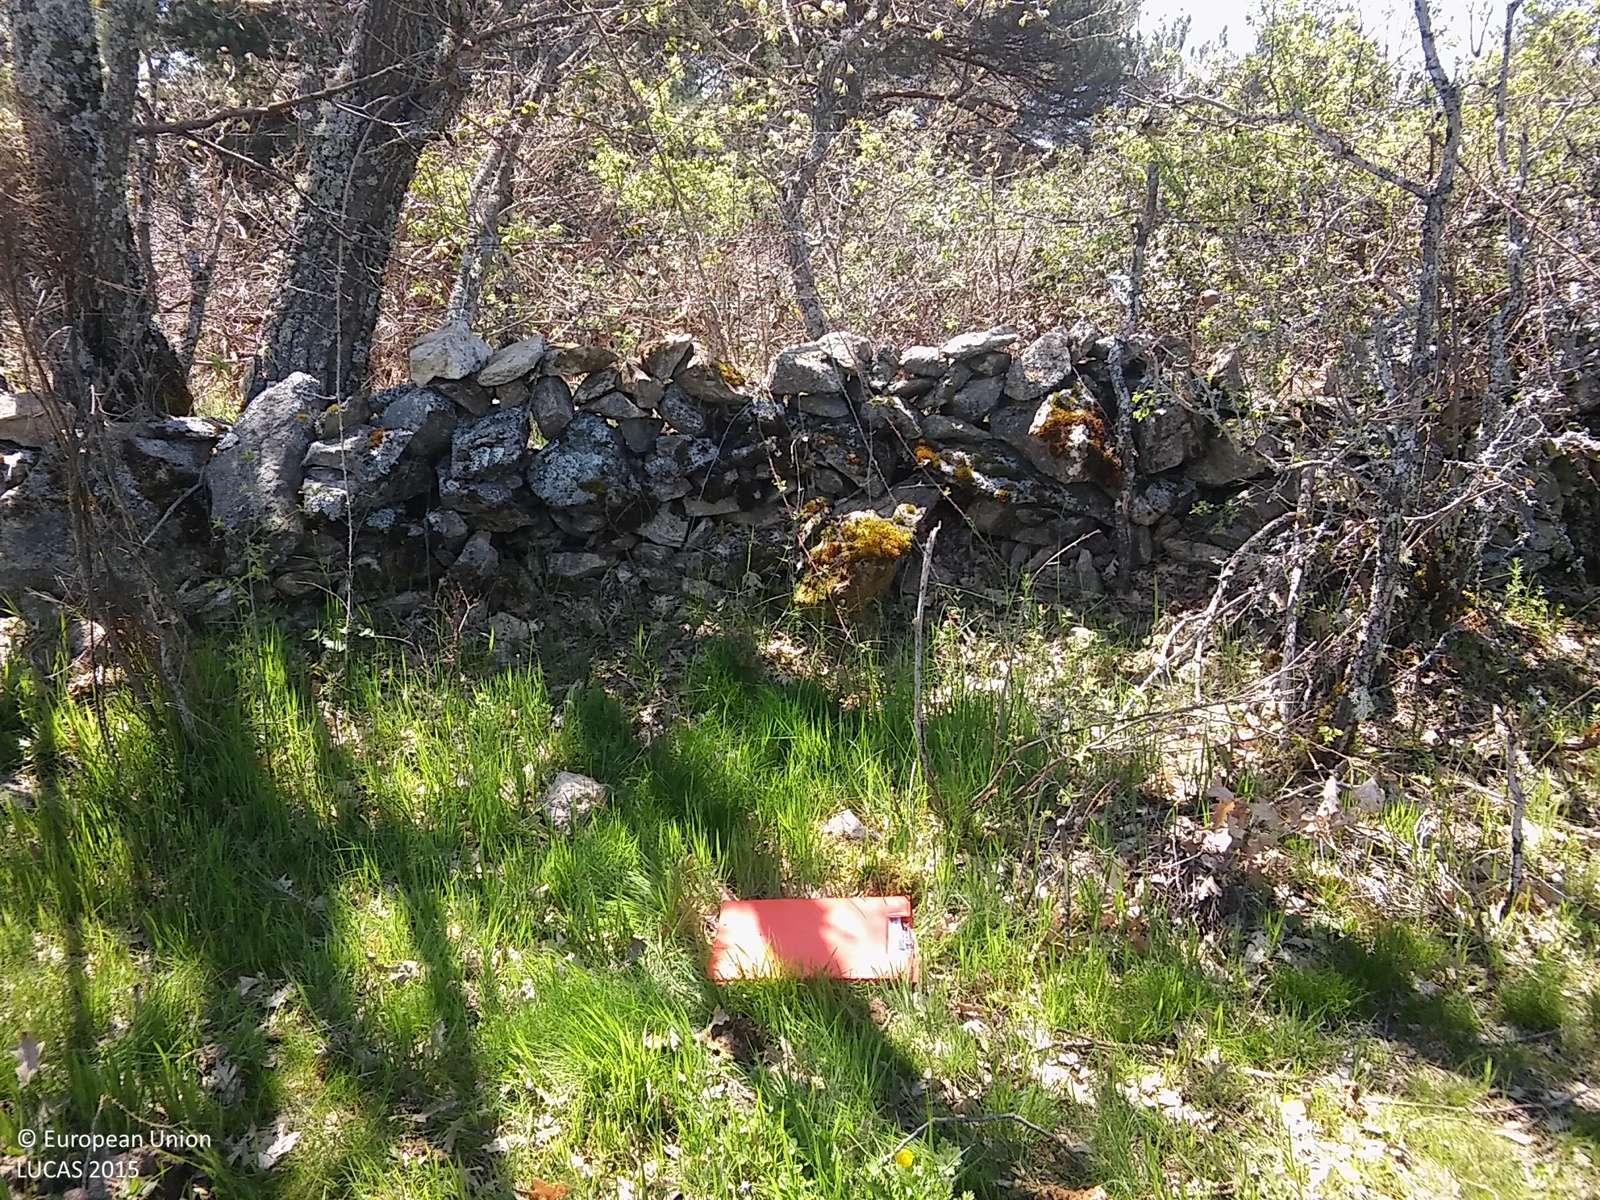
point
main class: Woodland
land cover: Broadleaved woodland
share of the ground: 25 - 50 %
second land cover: Grassland without tree/shrub cover
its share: > 75 %
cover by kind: herbaceous plants 50 %, broadleaved forest trees 45 %, shrubs 5 %
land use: Forestry
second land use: Agriculture (excluding fallow land and kitchen gardens)
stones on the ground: 10 - 25 %
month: May
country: ES
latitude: 41.0695
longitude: -3.8893
